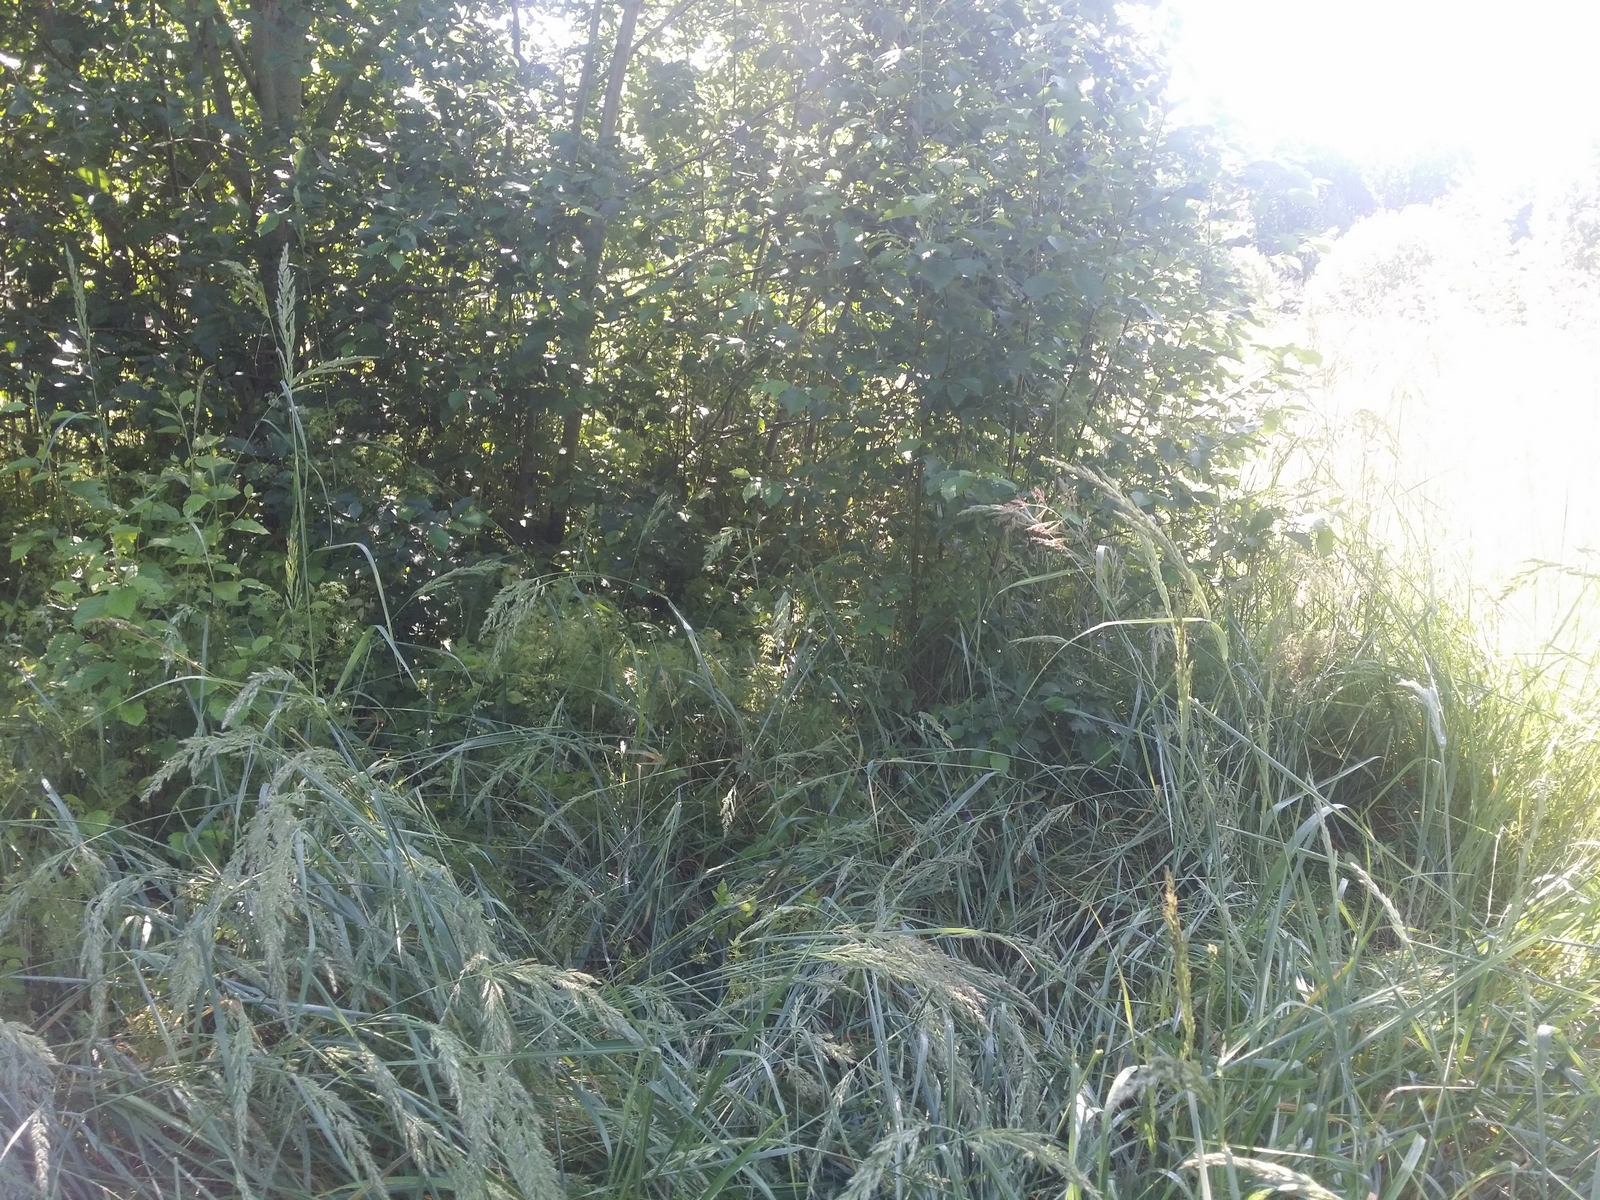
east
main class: Shrubland
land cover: Shrubland with sparse tree cover
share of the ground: 50 - 75 %
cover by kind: shrubs 65 %, herbaceous plants 30 %, broadleaved forest trees 5 %
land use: Semi-natural and natural areas not in use
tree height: < 5 m
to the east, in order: Shrubland with sparse tree cover; Spontaneously vegetated surfaces; Grassland with sparse tree/shrub cover; Spontaneously vegetated surfaces; Broadleaved woodland; Spontaneously vegetated surfaces; Broadleaved woodland
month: July
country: LV
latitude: 57.1471
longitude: 27.2408
